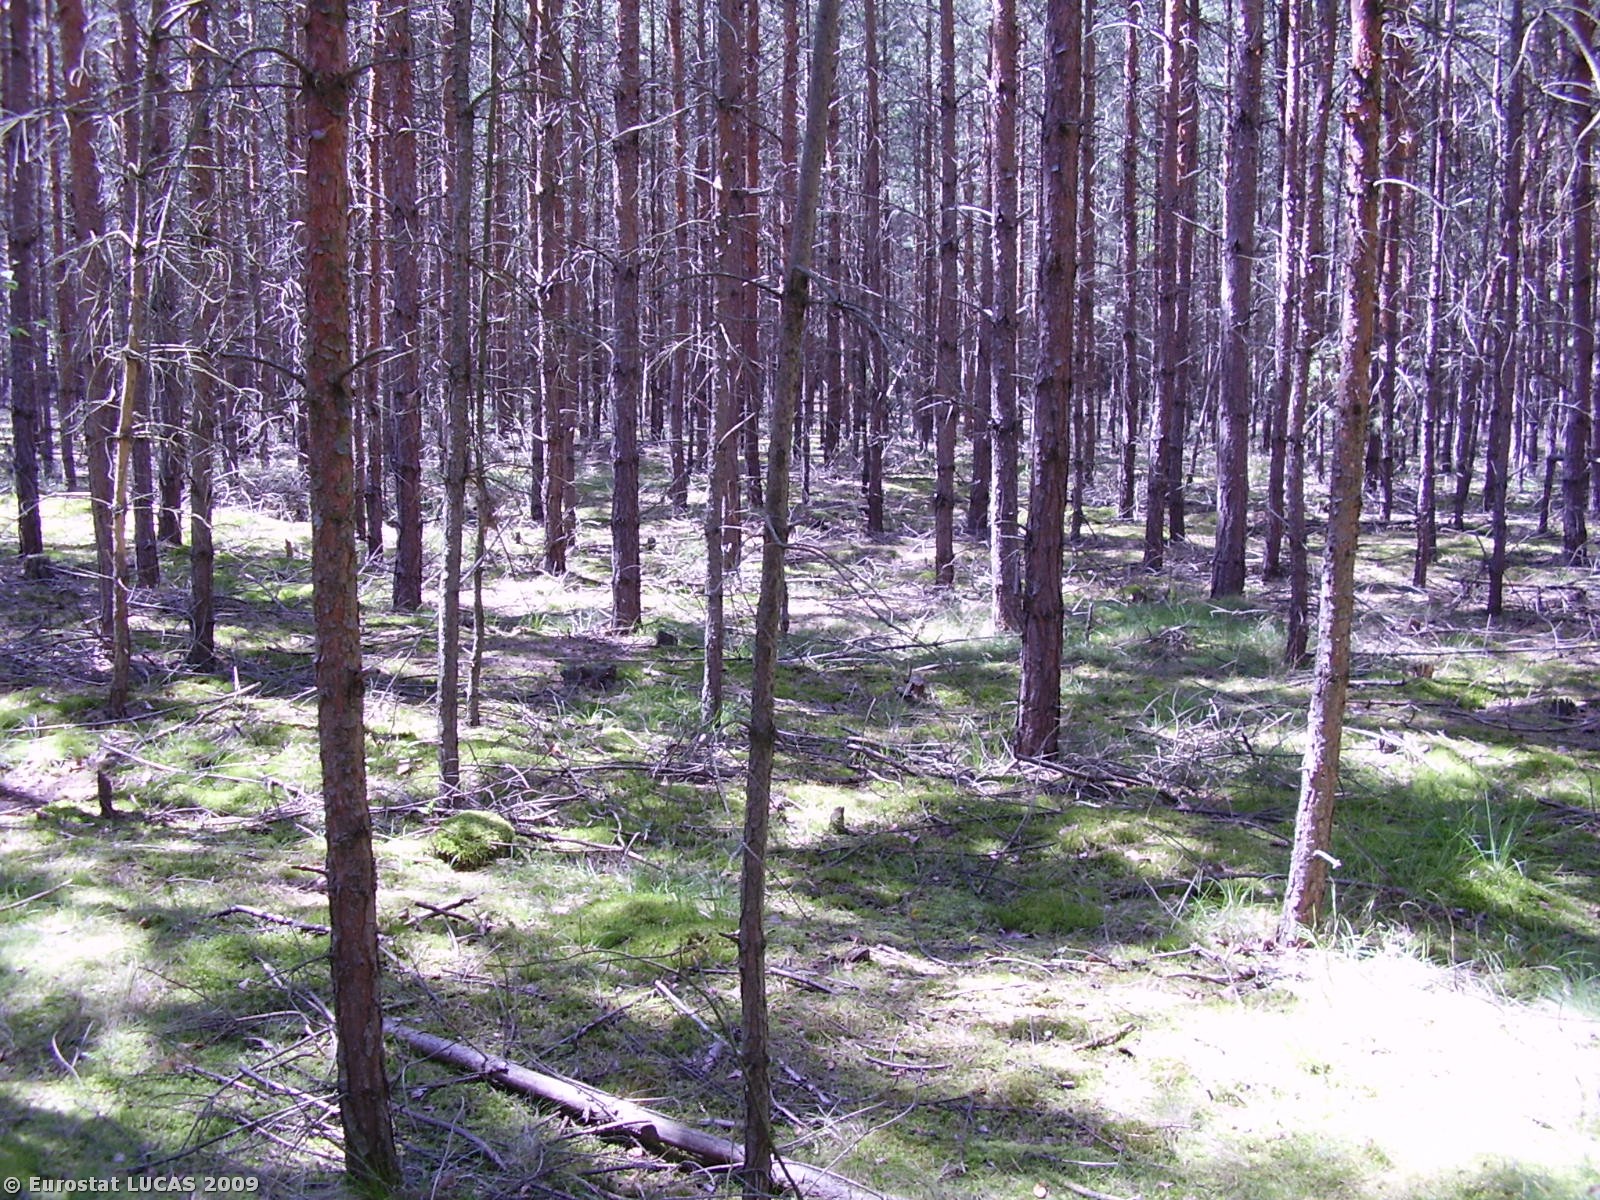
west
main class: Woodland
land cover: Coniferous woodland
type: hemiboreal forest and nemoral coniferous forest and mixed broadleaved-coniferous forest
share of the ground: > 75 %
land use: Forestry
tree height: > 5 m
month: July
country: PL
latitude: 51.8888
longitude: 16.2399
